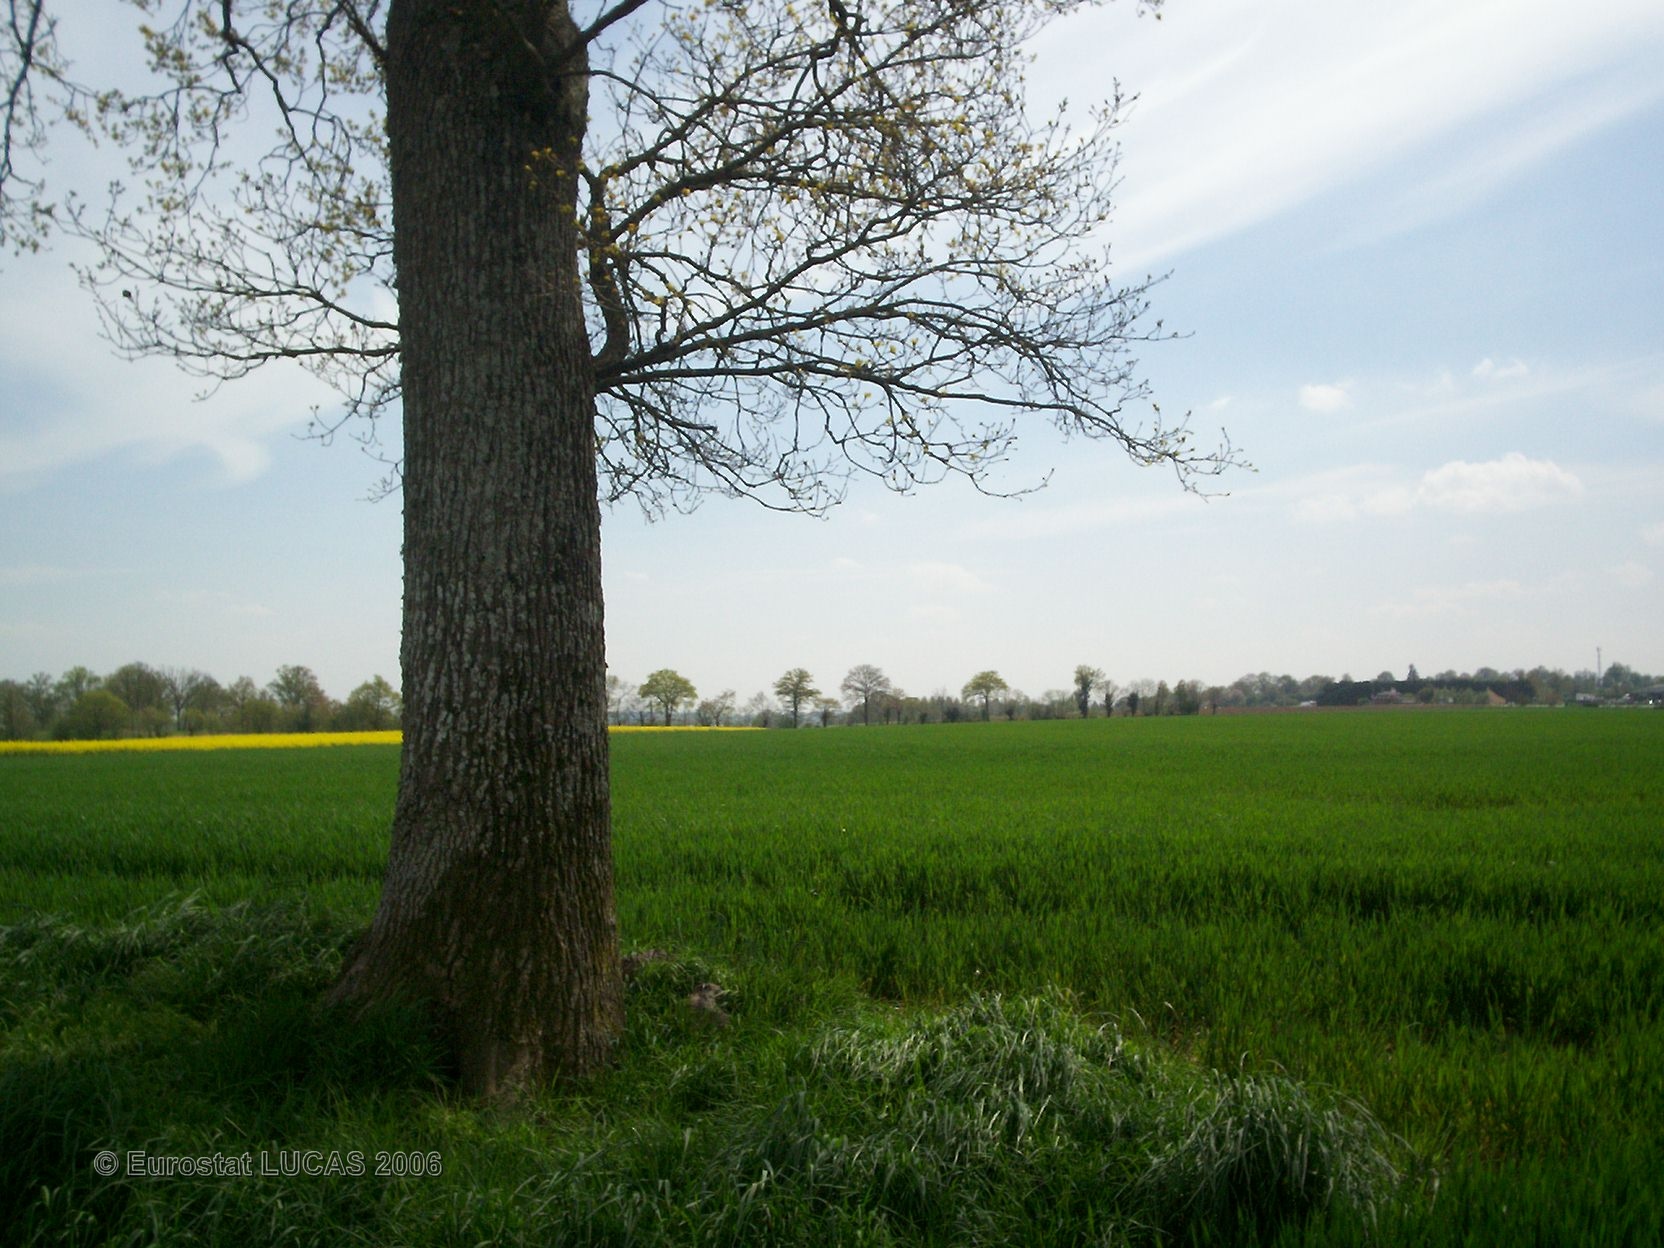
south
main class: Cropland
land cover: Common wheat
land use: Agriculture (excluding fallow land and kitchen gardens)
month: May
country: FR
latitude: 48.2139
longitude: -0.6541
